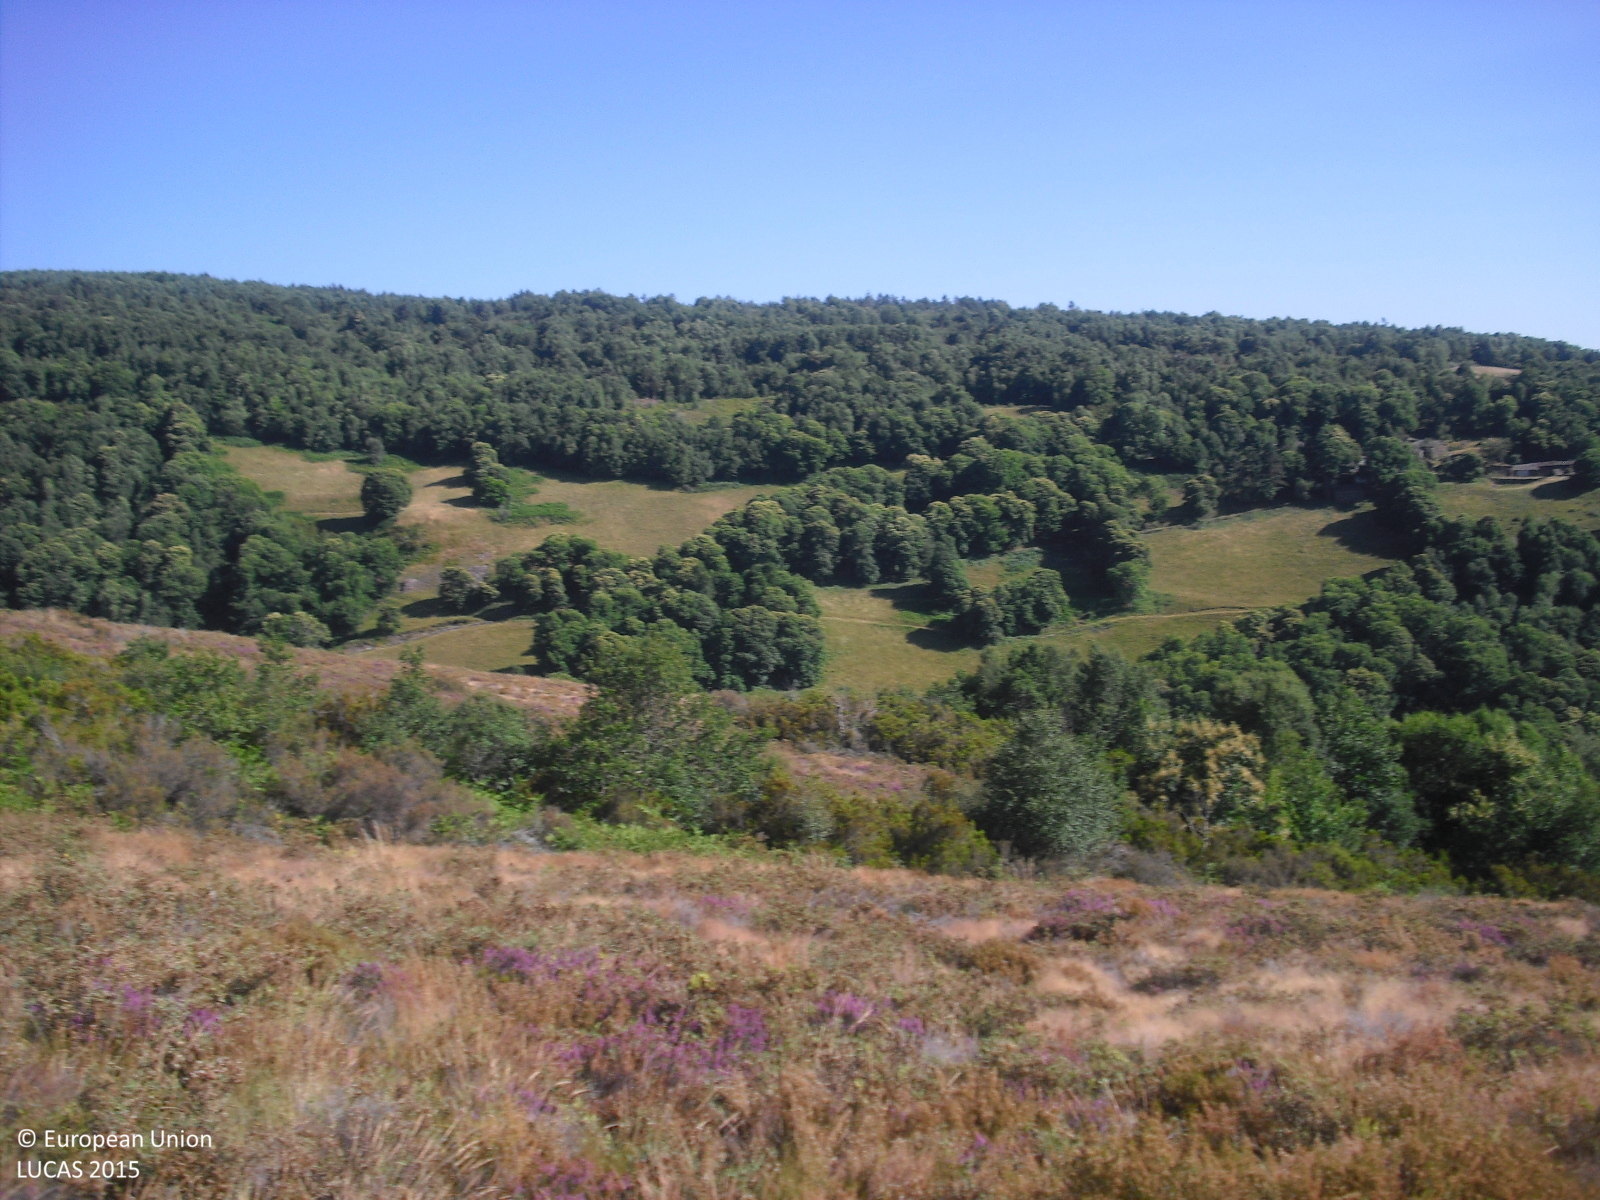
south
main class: Shrubland
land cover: Shrubland without tree cover
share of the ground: > 75 %
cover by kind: shrubs 70 %, herbaceous plants 20 %, consolidated bare surface 5 %, unconsolidated bare surface 5 %
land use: Semi-natural and natural areas not in use
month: July
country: ES
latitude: 42.6229
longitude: -7.3181
